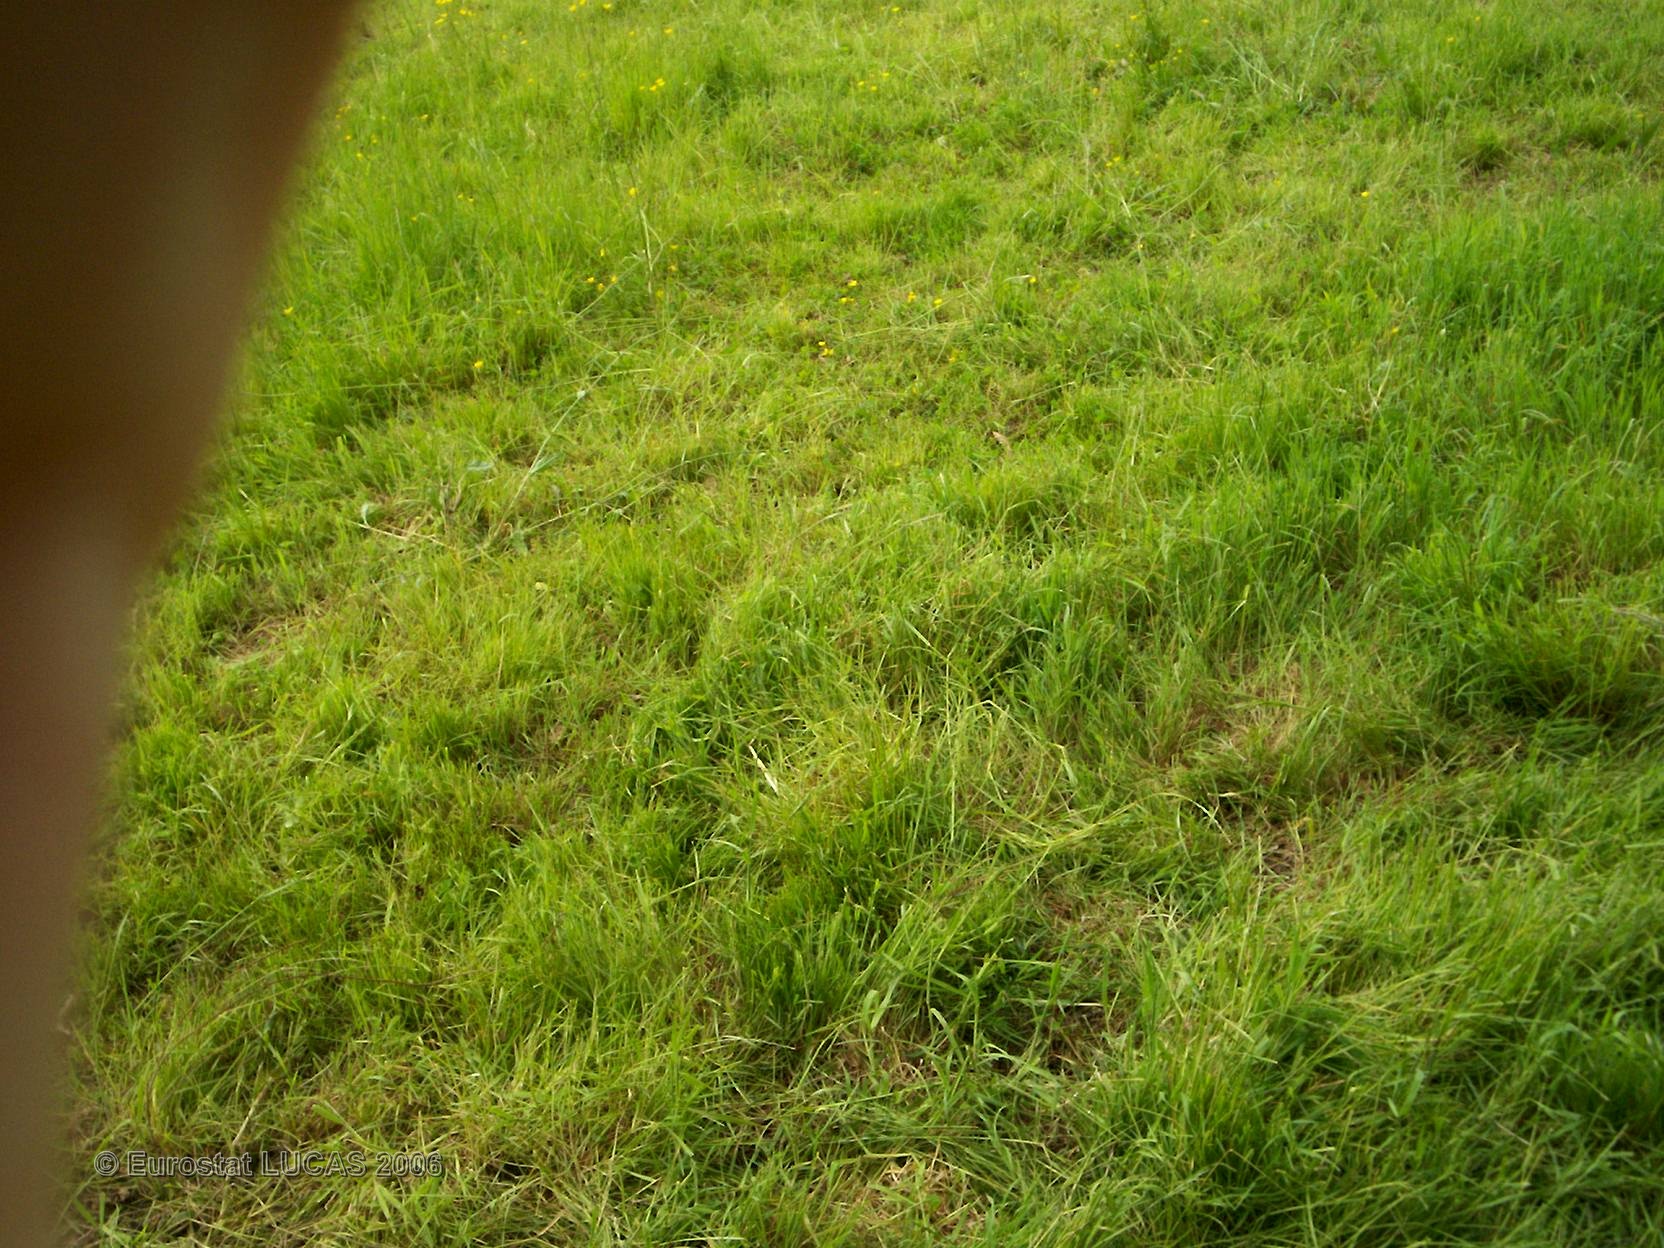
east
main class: Grassland
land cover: Grassland without tree/shrub cover
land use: Agriculture (excluding fallow land and kitchen gardens)
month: May
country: FR
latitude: 47.7438
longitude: -1.5274
